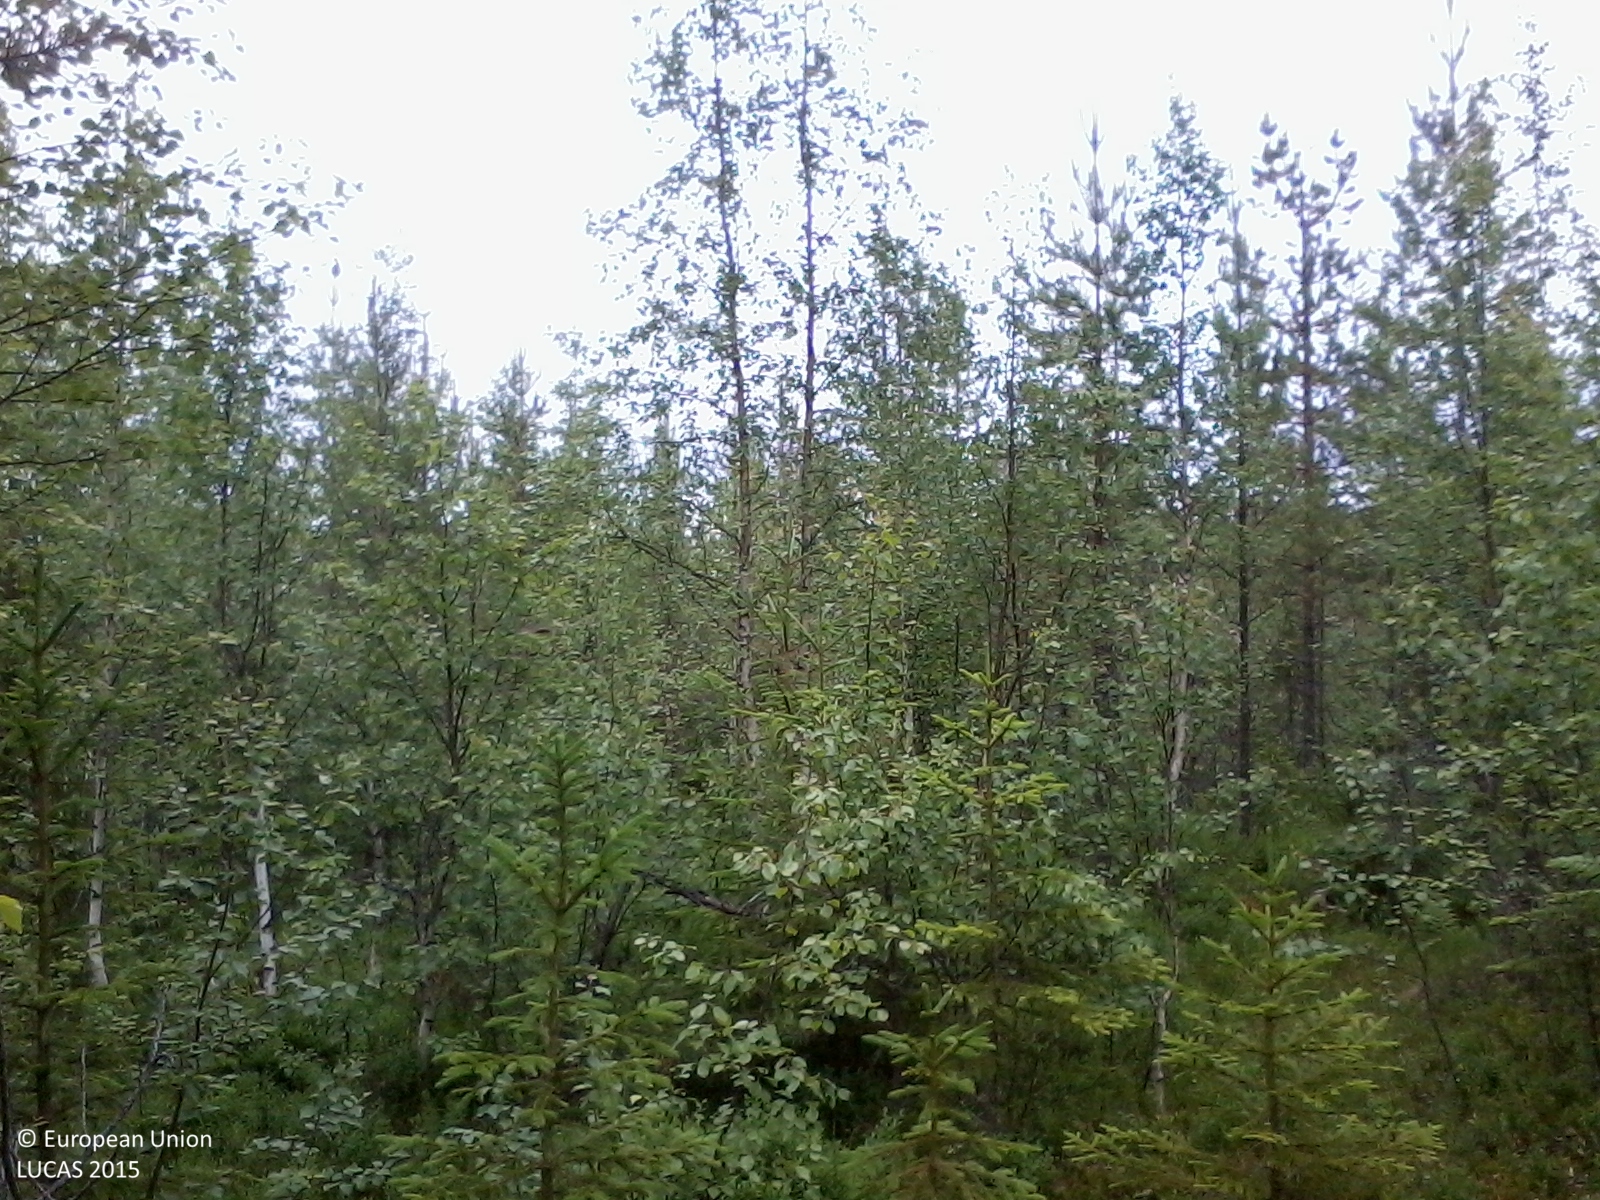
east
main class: Woodland
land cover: Pine dominated mixed woodland
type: boreal forest
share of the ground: 50 - 75 %
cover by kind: coniferous forest trees 50 %, broadleaved forest trees 20 %, shrubs 15 %, herbaceous plants 10 %, lichens and mosses 5 %
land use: Forestry
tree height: < 5 m
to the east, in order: Pine dominated mixed woodland; Ditches and canals; Paved roads, cycling and walking lanes; Pine dominated coniferous woodland
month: July
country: SE
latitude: 63.5521
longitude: 18.1654
